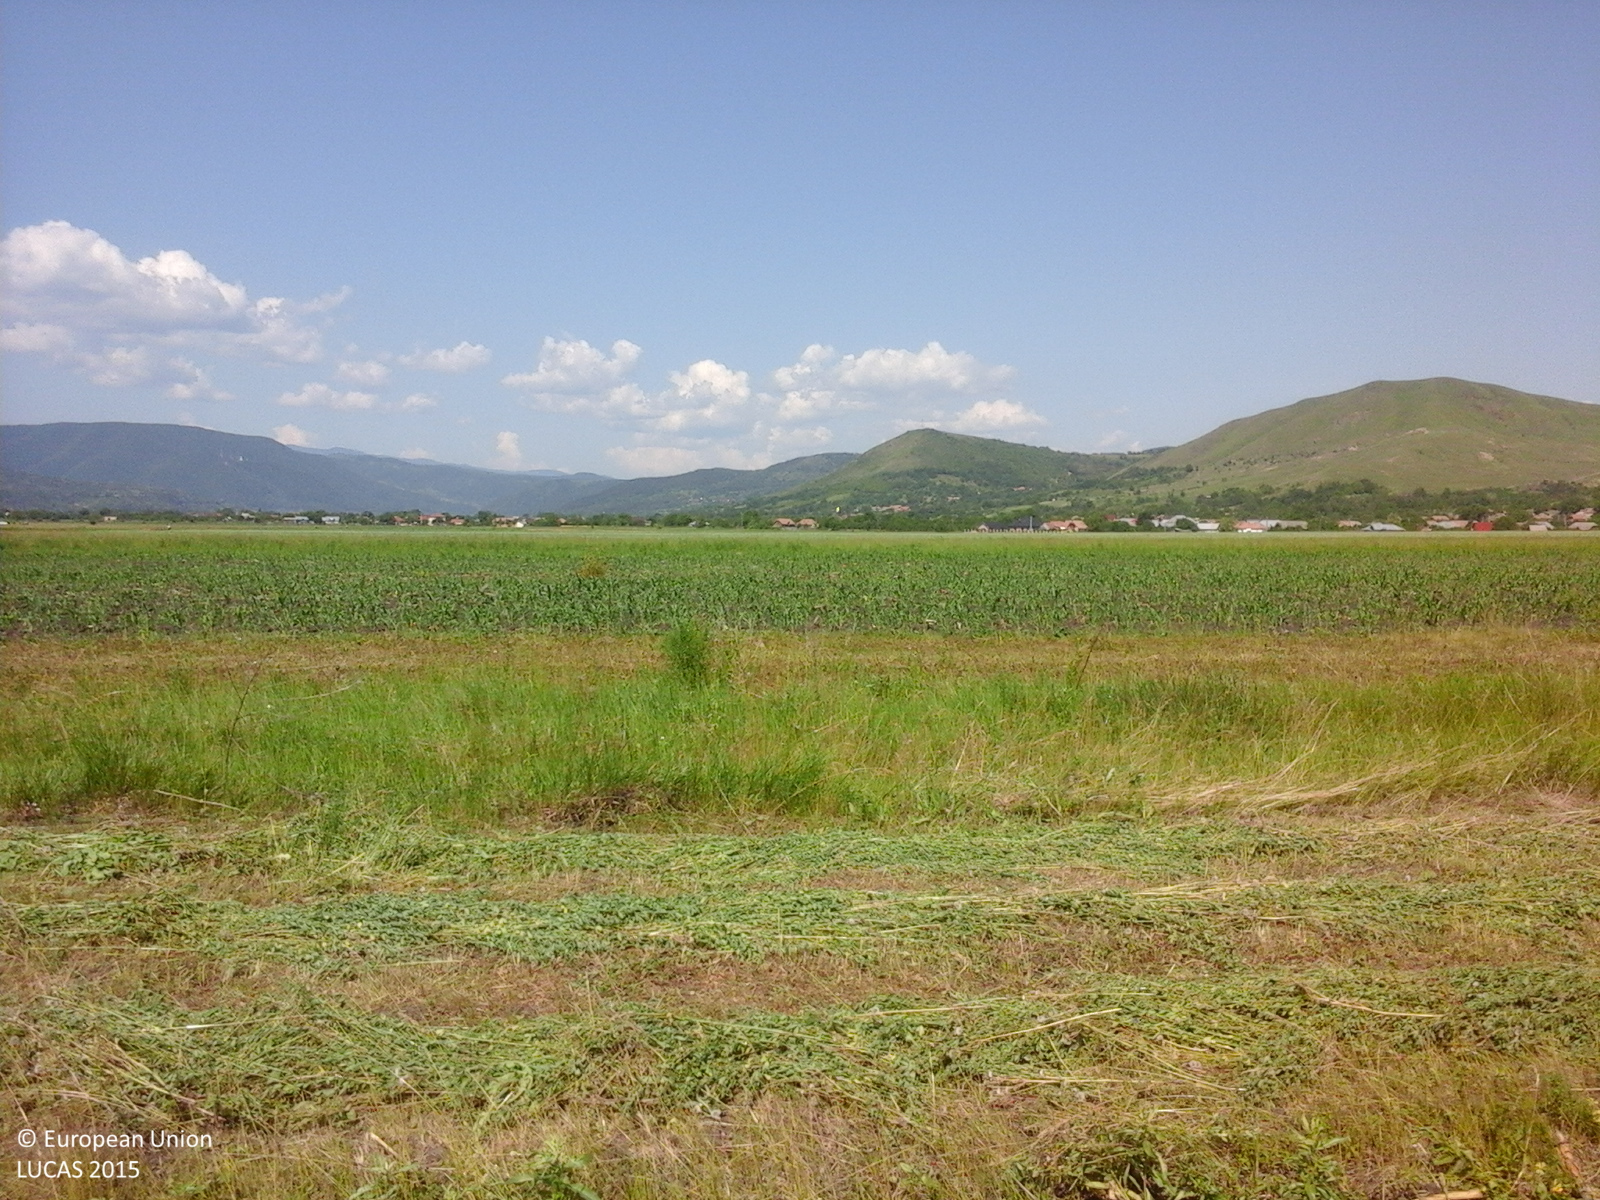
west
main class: Cropland
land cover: Maize
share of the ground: 10 - 25 %
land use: Agriculture (excluding fallow land and kitchen gardens)
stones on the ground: < 10 %
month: June
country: RO
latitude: 46.2786
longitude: 26.6839
